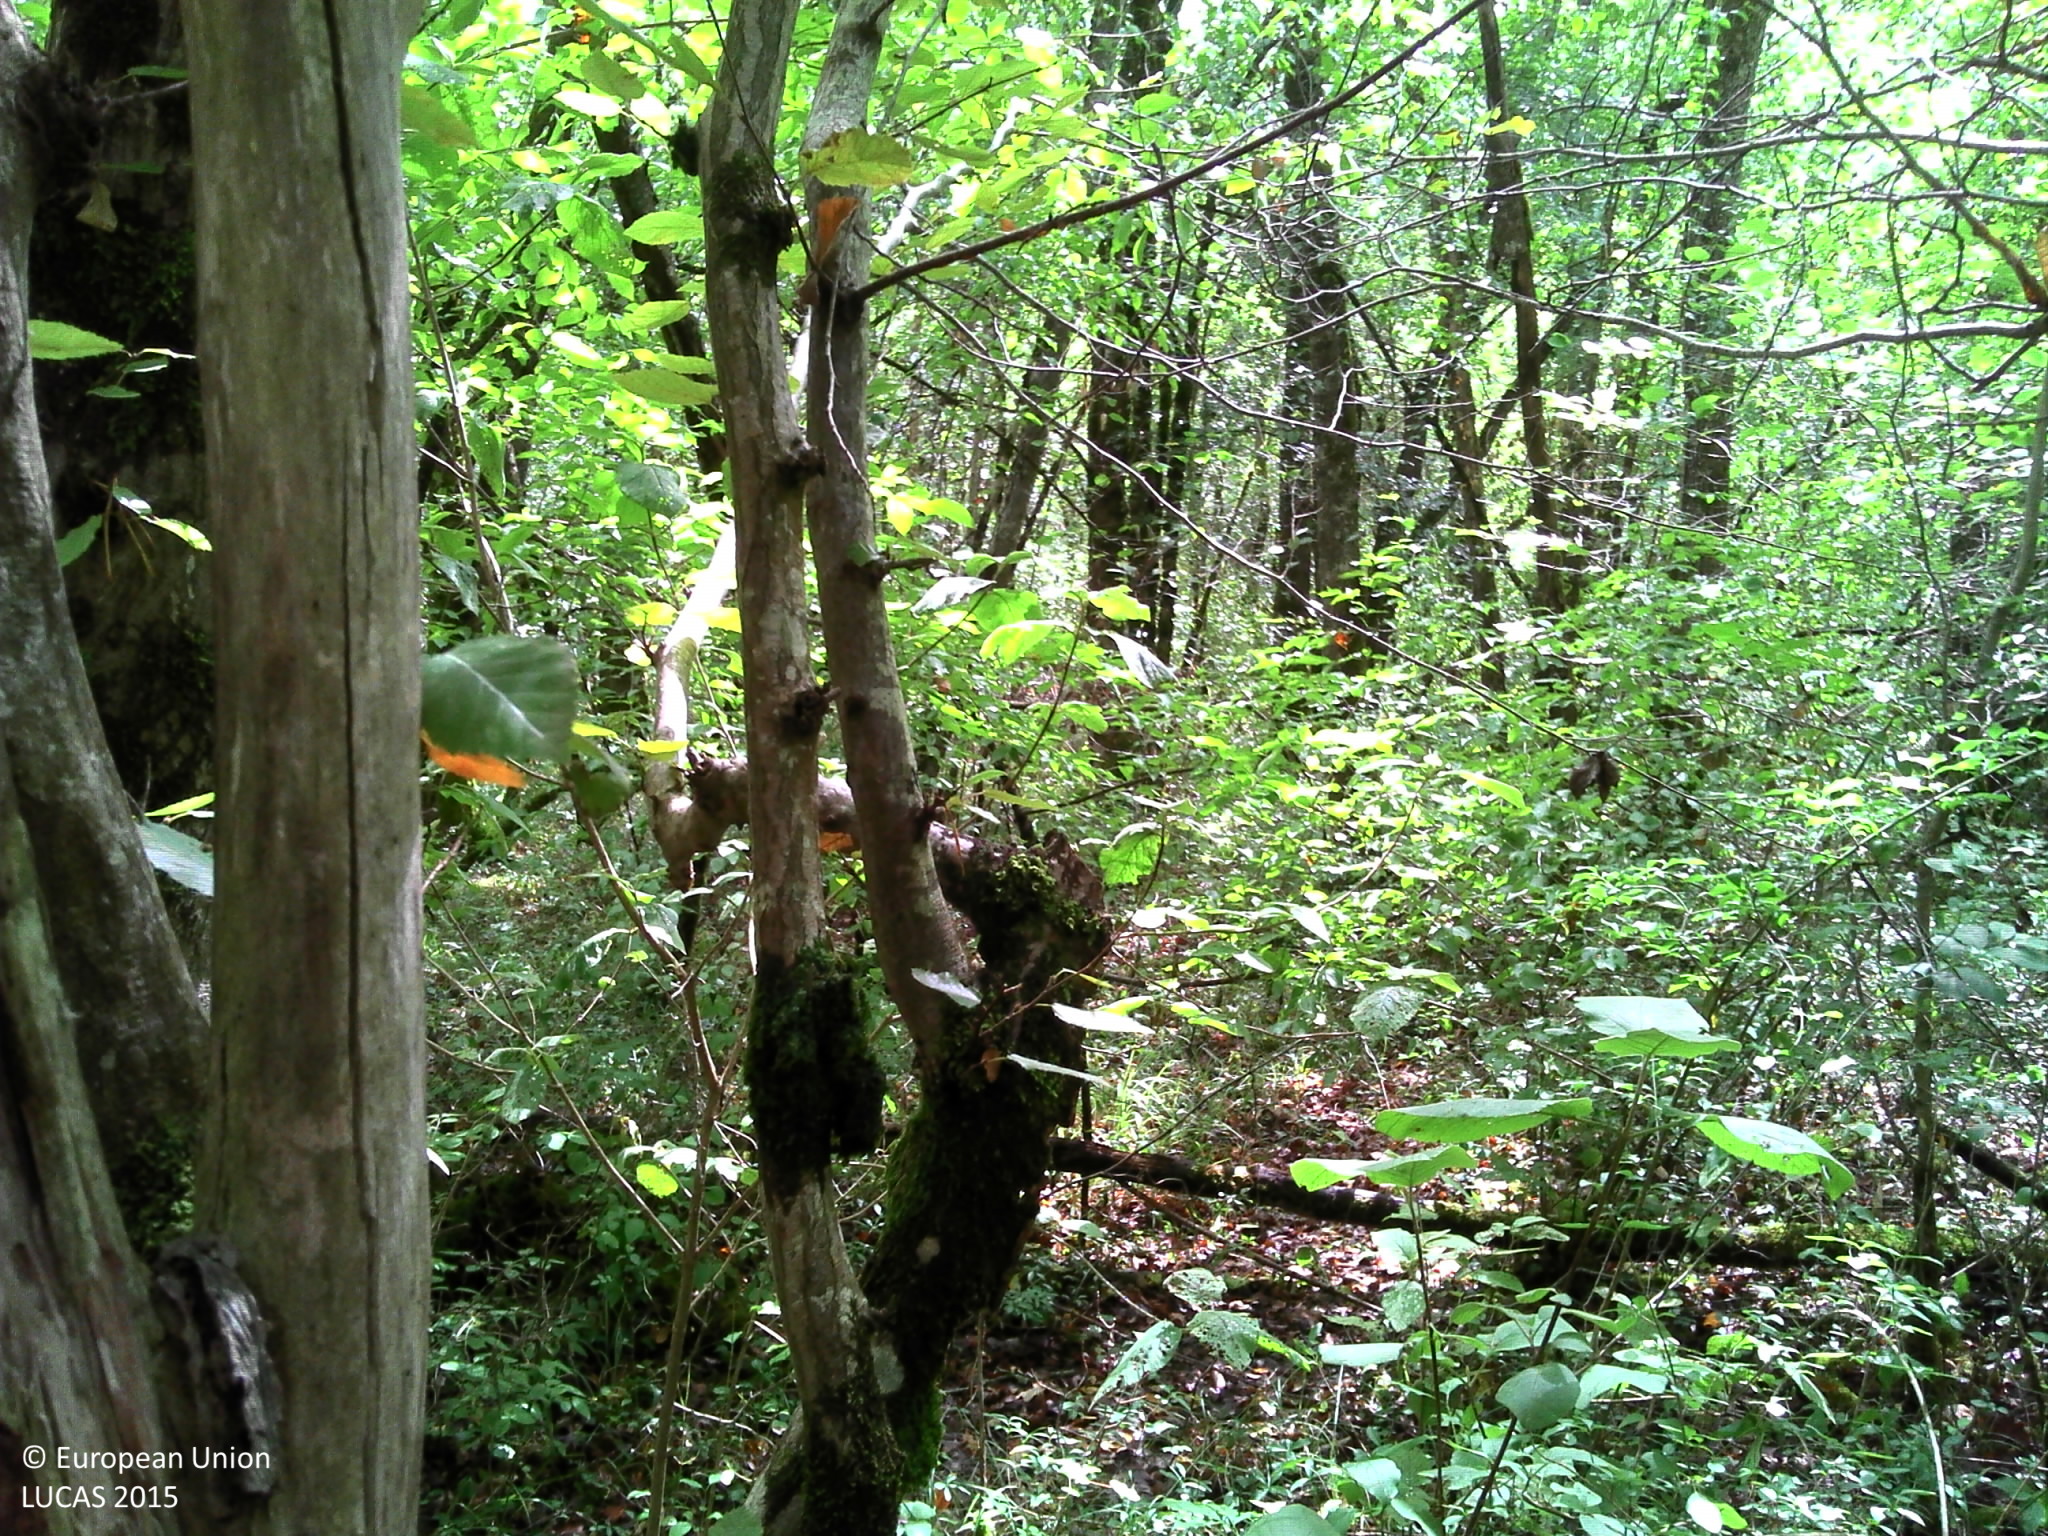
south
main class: Woodland
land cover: Broadleaved woodland
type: mesophytic deciduous forest
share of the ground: > 75 %
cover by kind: broadleaved forest trees 85 %, shrubs 5 %, herbaceous plants 5 %, lichens and mosses 5 %
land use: Forestry
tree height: > 5 m
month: August
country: FR
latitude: 47.9407
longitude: 4.8448
